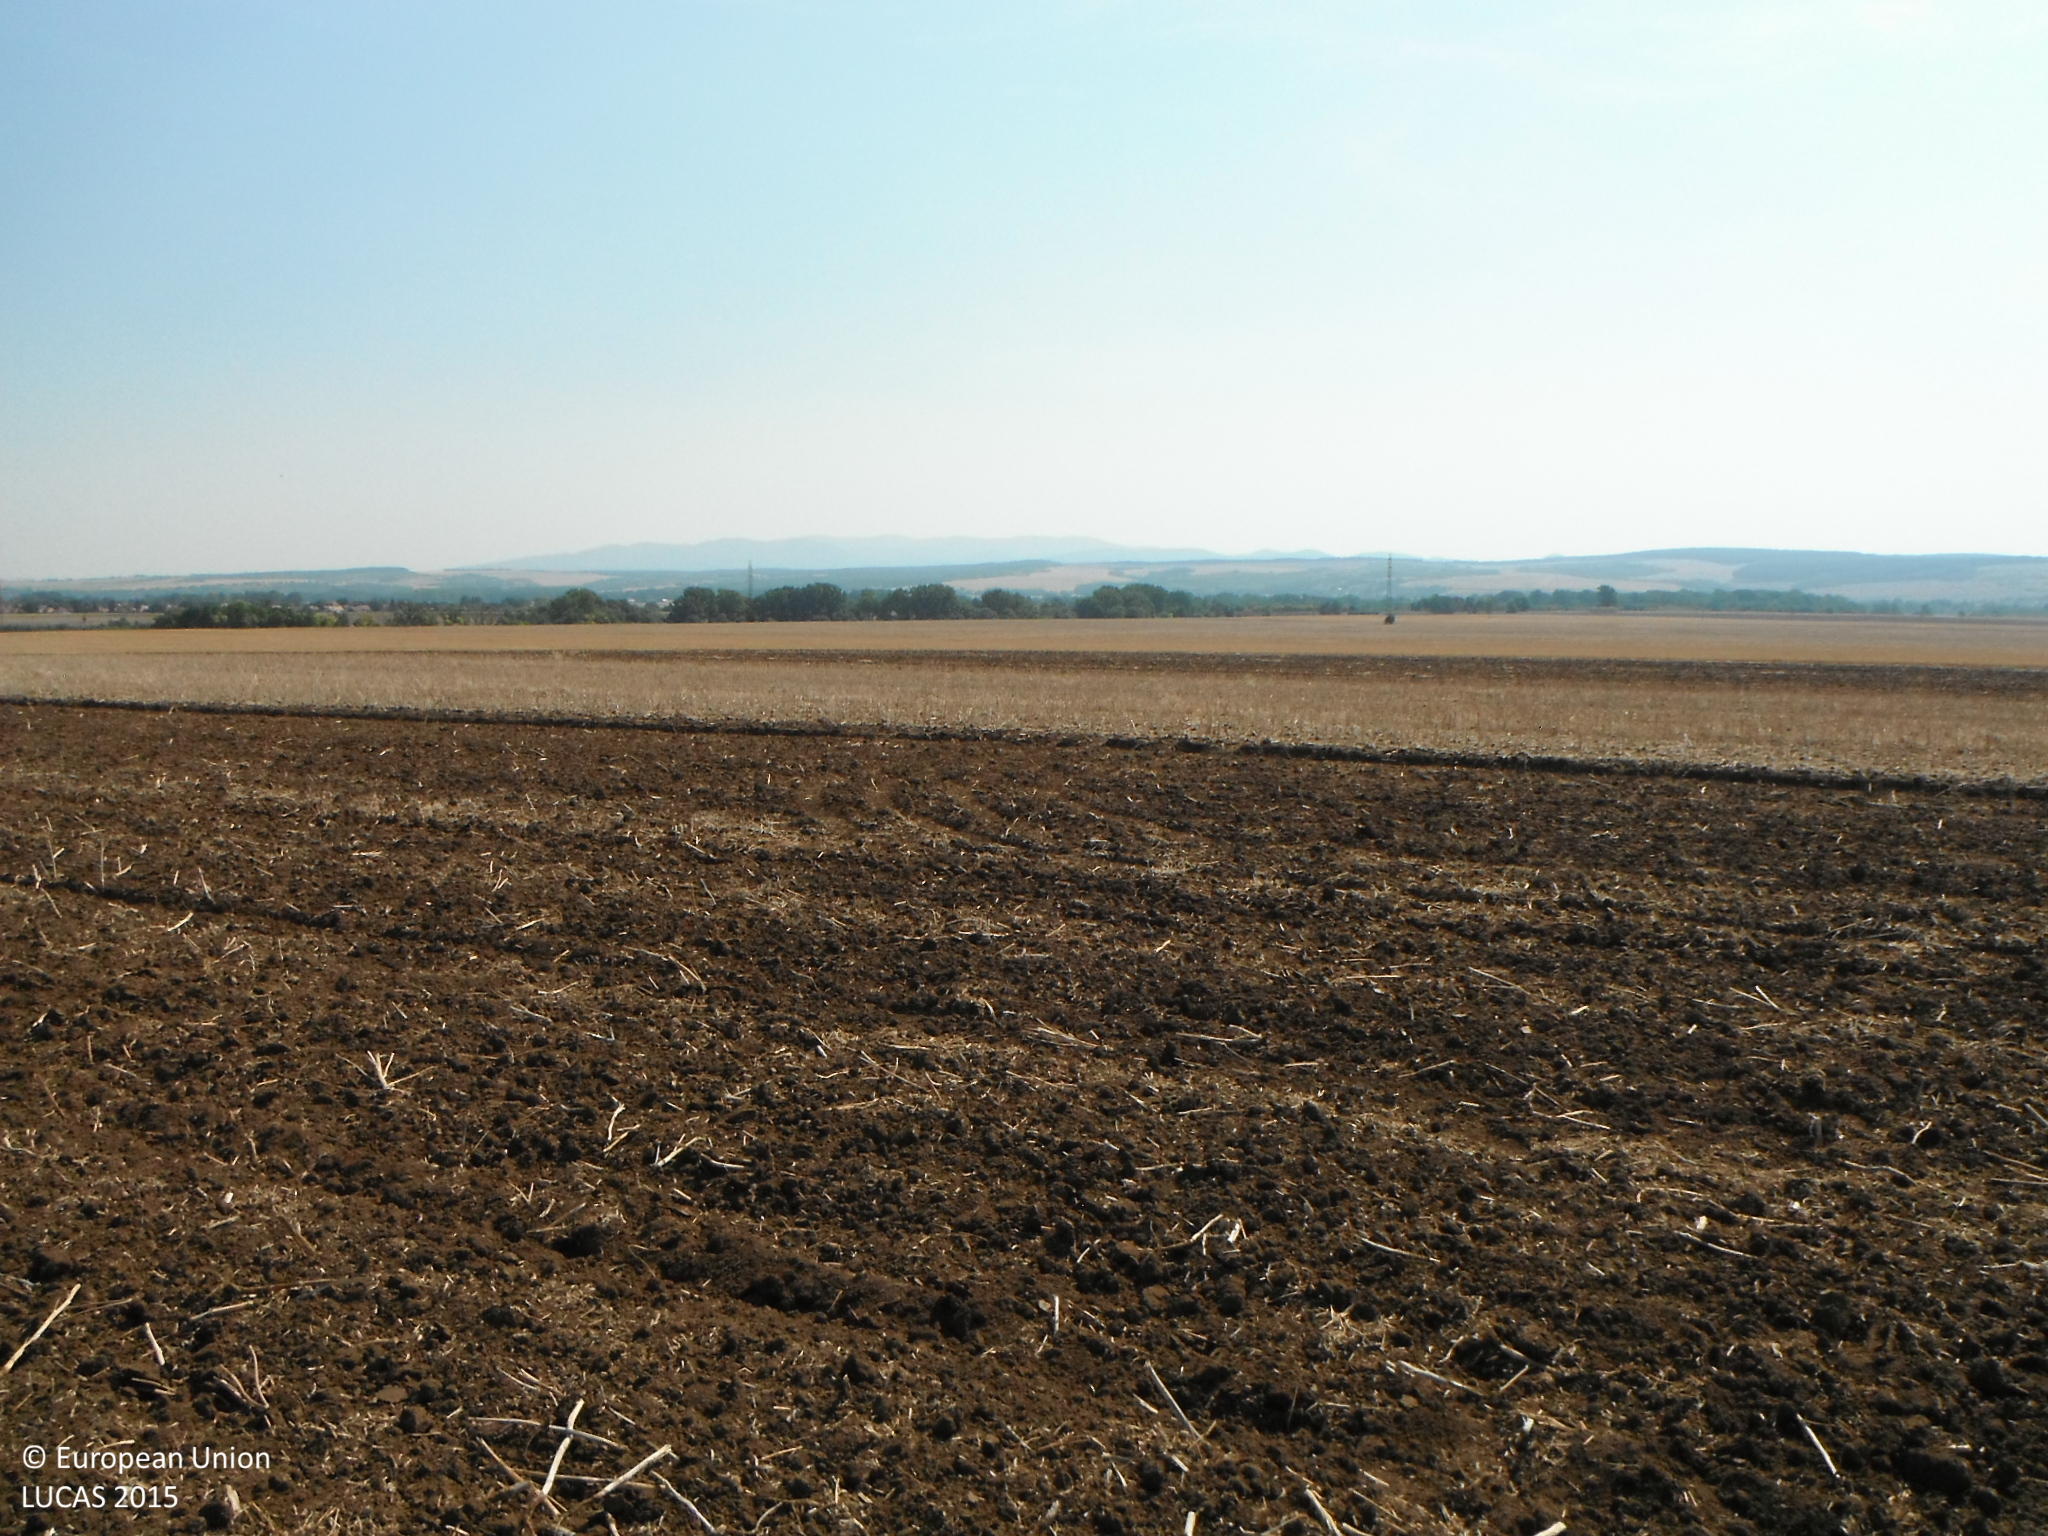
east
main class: Cropland
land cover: Rape and turnip rape
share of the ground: < 10 %
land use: Agriculture (excluding fallow land and kitchen gardens)
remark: Tilled/Sowed
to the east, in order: Rape and turnip rape; Common wheat
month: August
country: SK
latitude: 47.9037
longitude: 18.6179
